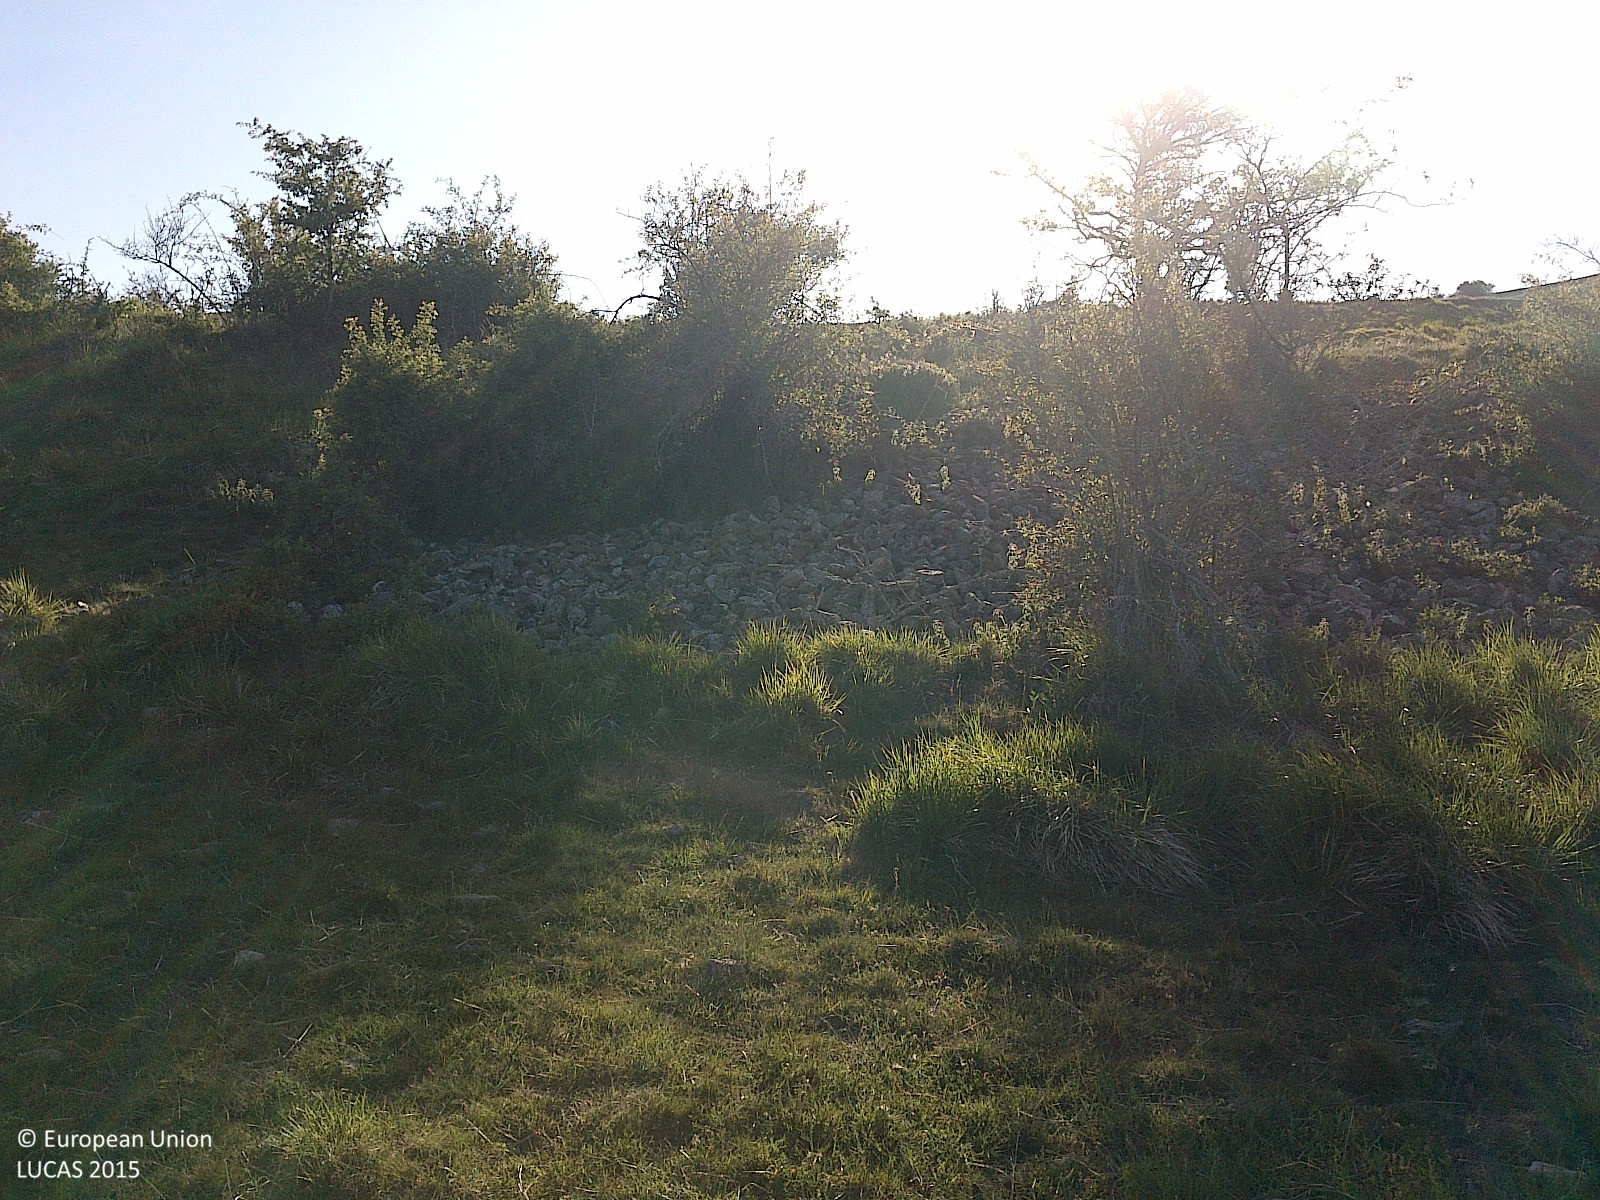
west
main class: Grassland
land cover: Grassland with sparse tree/shrub cover
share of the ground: 50 - 75 %
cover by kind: herbaceous plants 65 %, consolidated bare surface 25 %, broadleaved forest trees 5 %, shrubs 5 %
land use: Agriculture (excluding fallow land and kitchen gardens)
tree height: < 5 m
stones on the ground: < 10 %
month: May
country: ES
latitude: 42.0233
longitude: -2.3459
